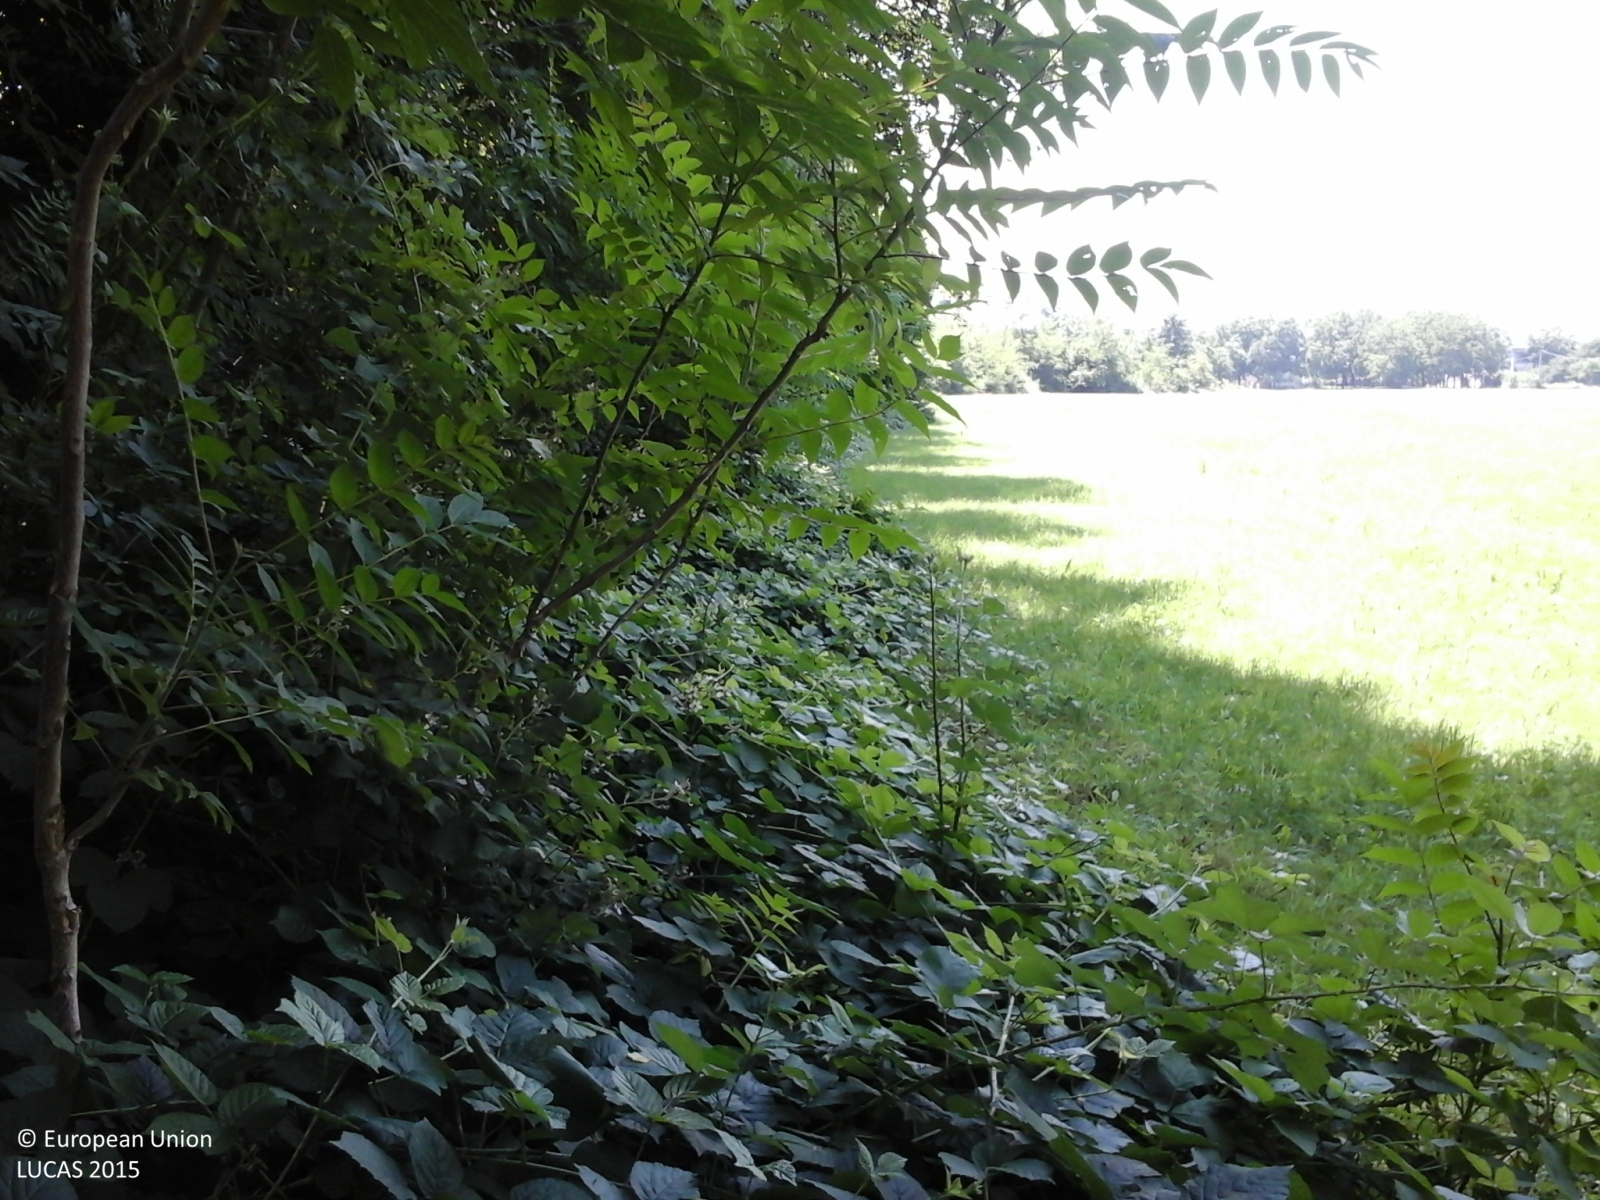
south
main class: Woodland
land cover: Broadleaved woodland
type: thermophilous deciduous forest
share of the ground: > 75 %
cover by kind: broadleaved forest trees 80 %, shrubs 15 %, herbaceous plants 5 %
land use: Semi-natural and natural areas not in use
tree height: > 5 m
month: June
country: IT
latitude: 44.3794
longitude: 7.7080
